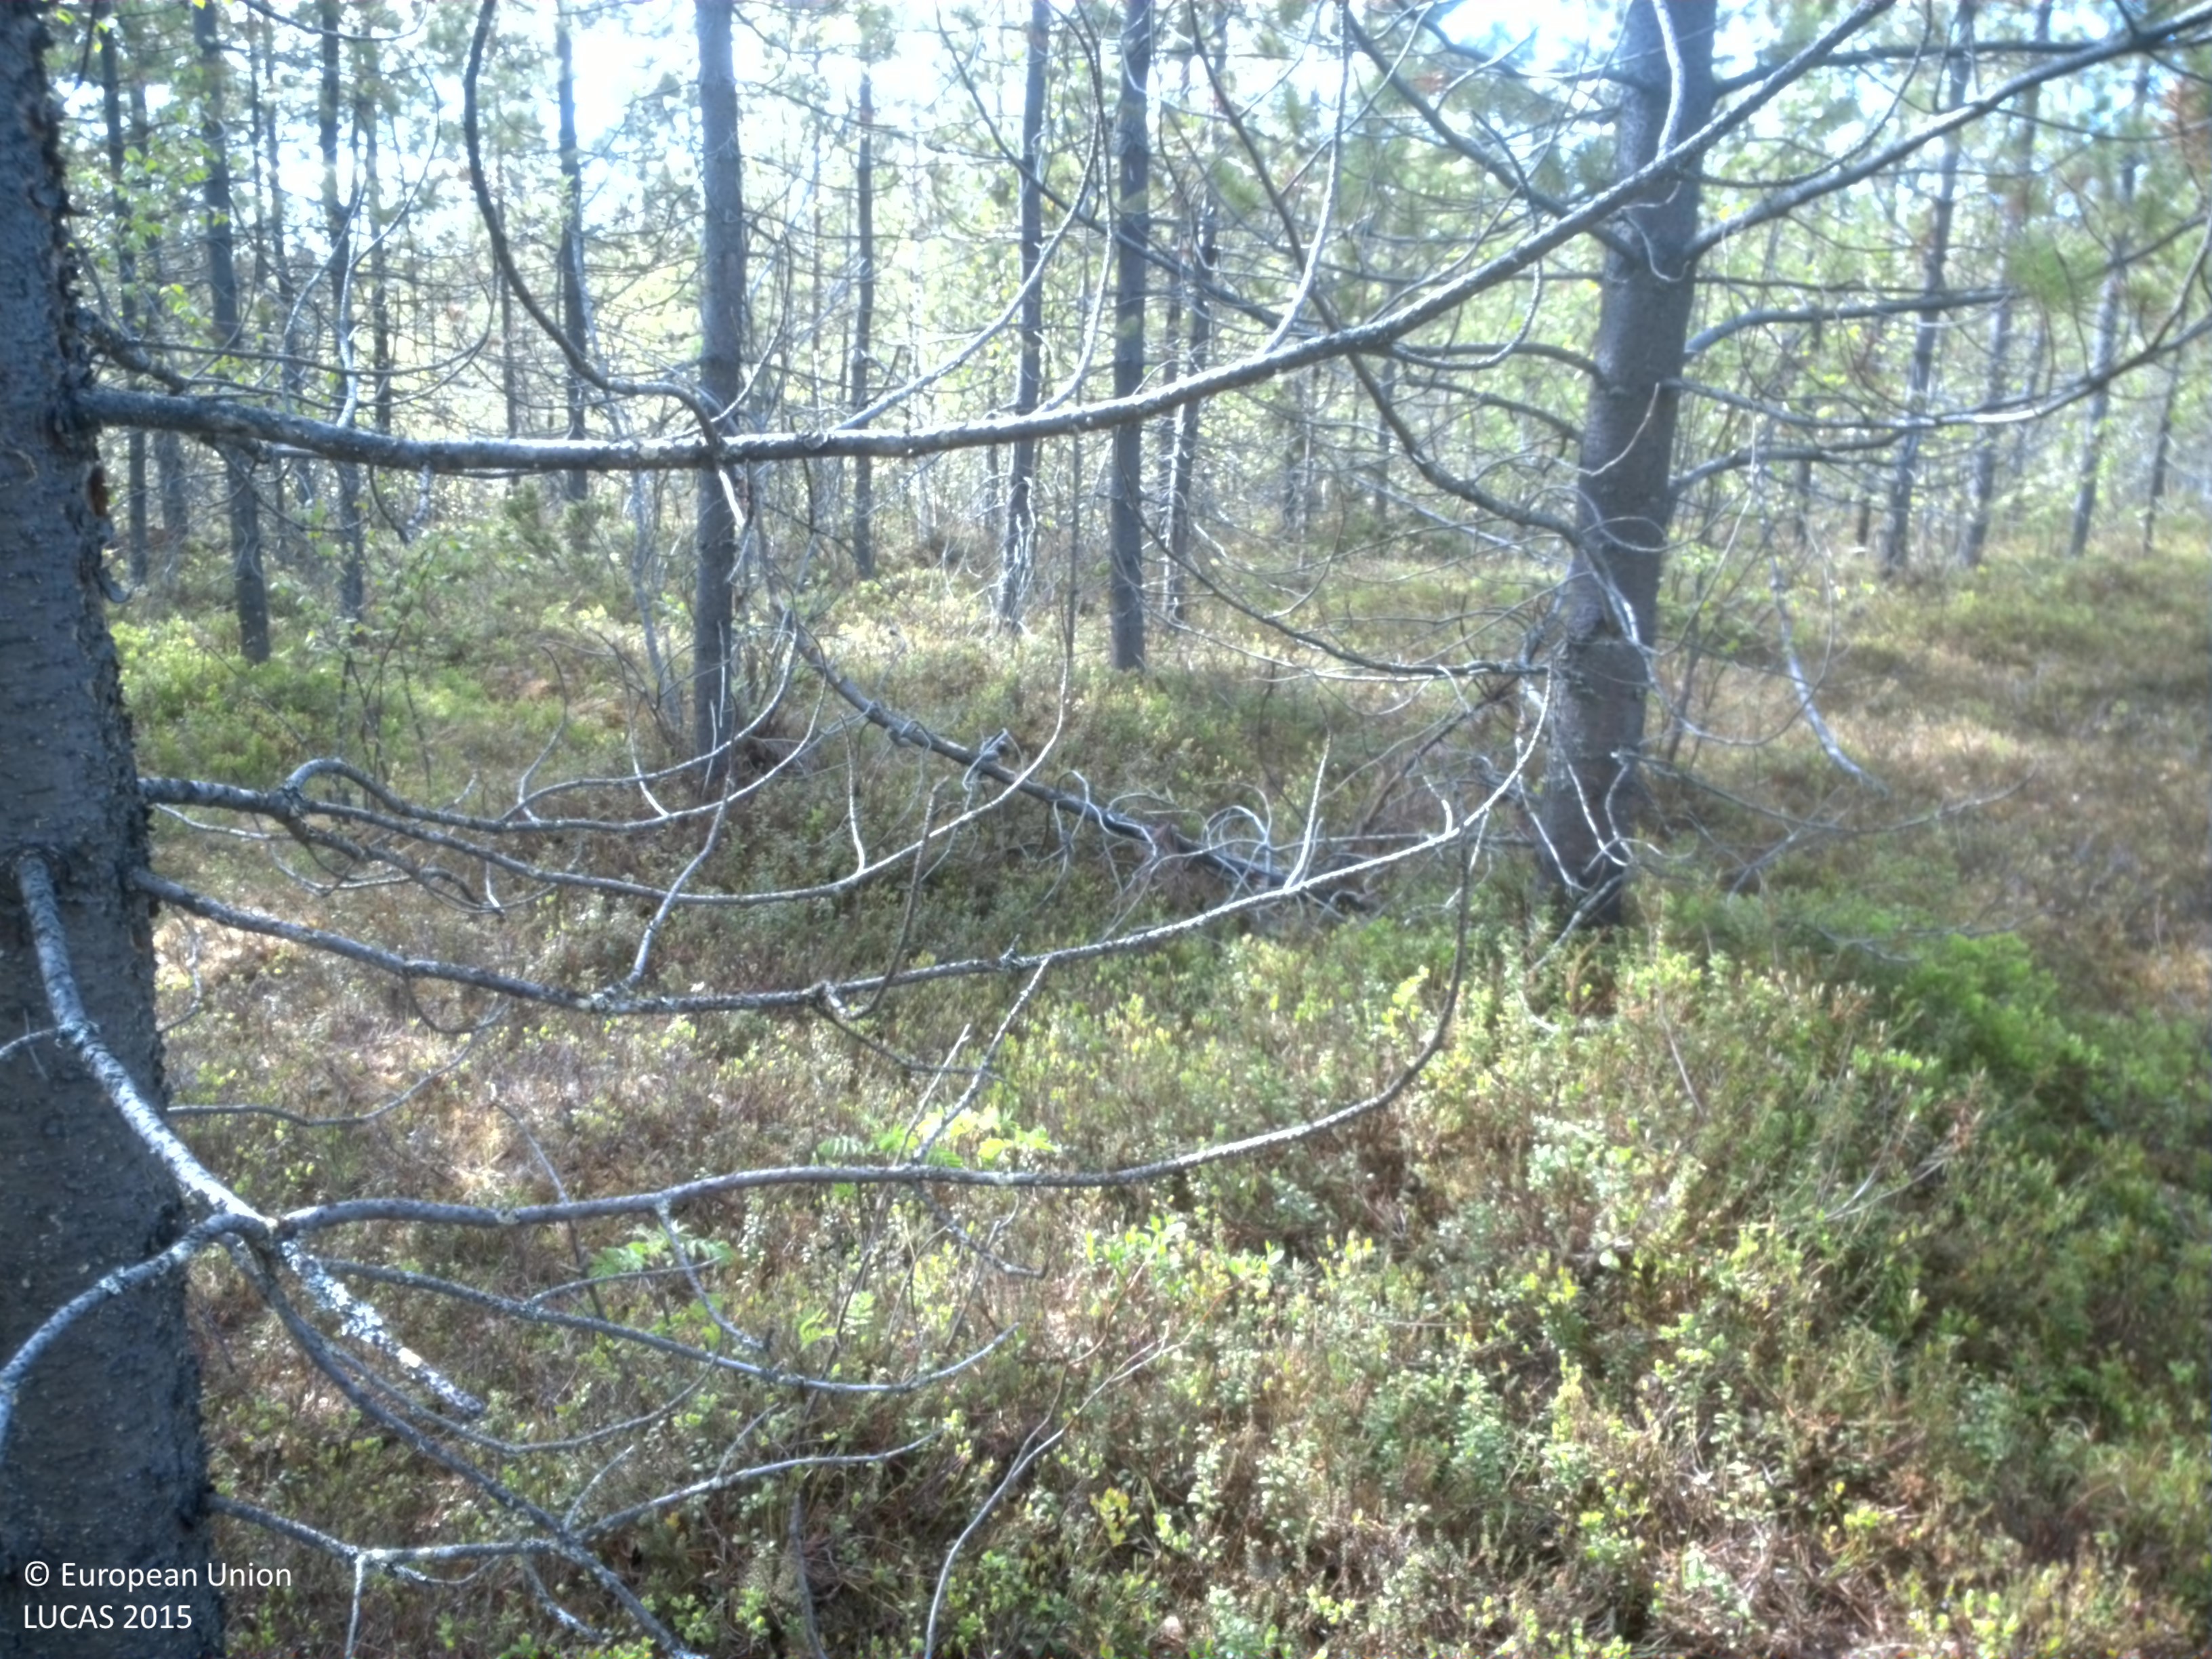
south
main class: Woodland
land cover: Pine dominated mixed woodland
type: boreal forest
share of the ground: 25 - 50 %
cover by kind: shrubs 60 %, coniferous forest trees 25 %, broadleaved forest trees 15 %
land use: Forestry
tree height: > 5 m
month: June
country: SE
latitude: 67.0041
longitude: 21.7253
